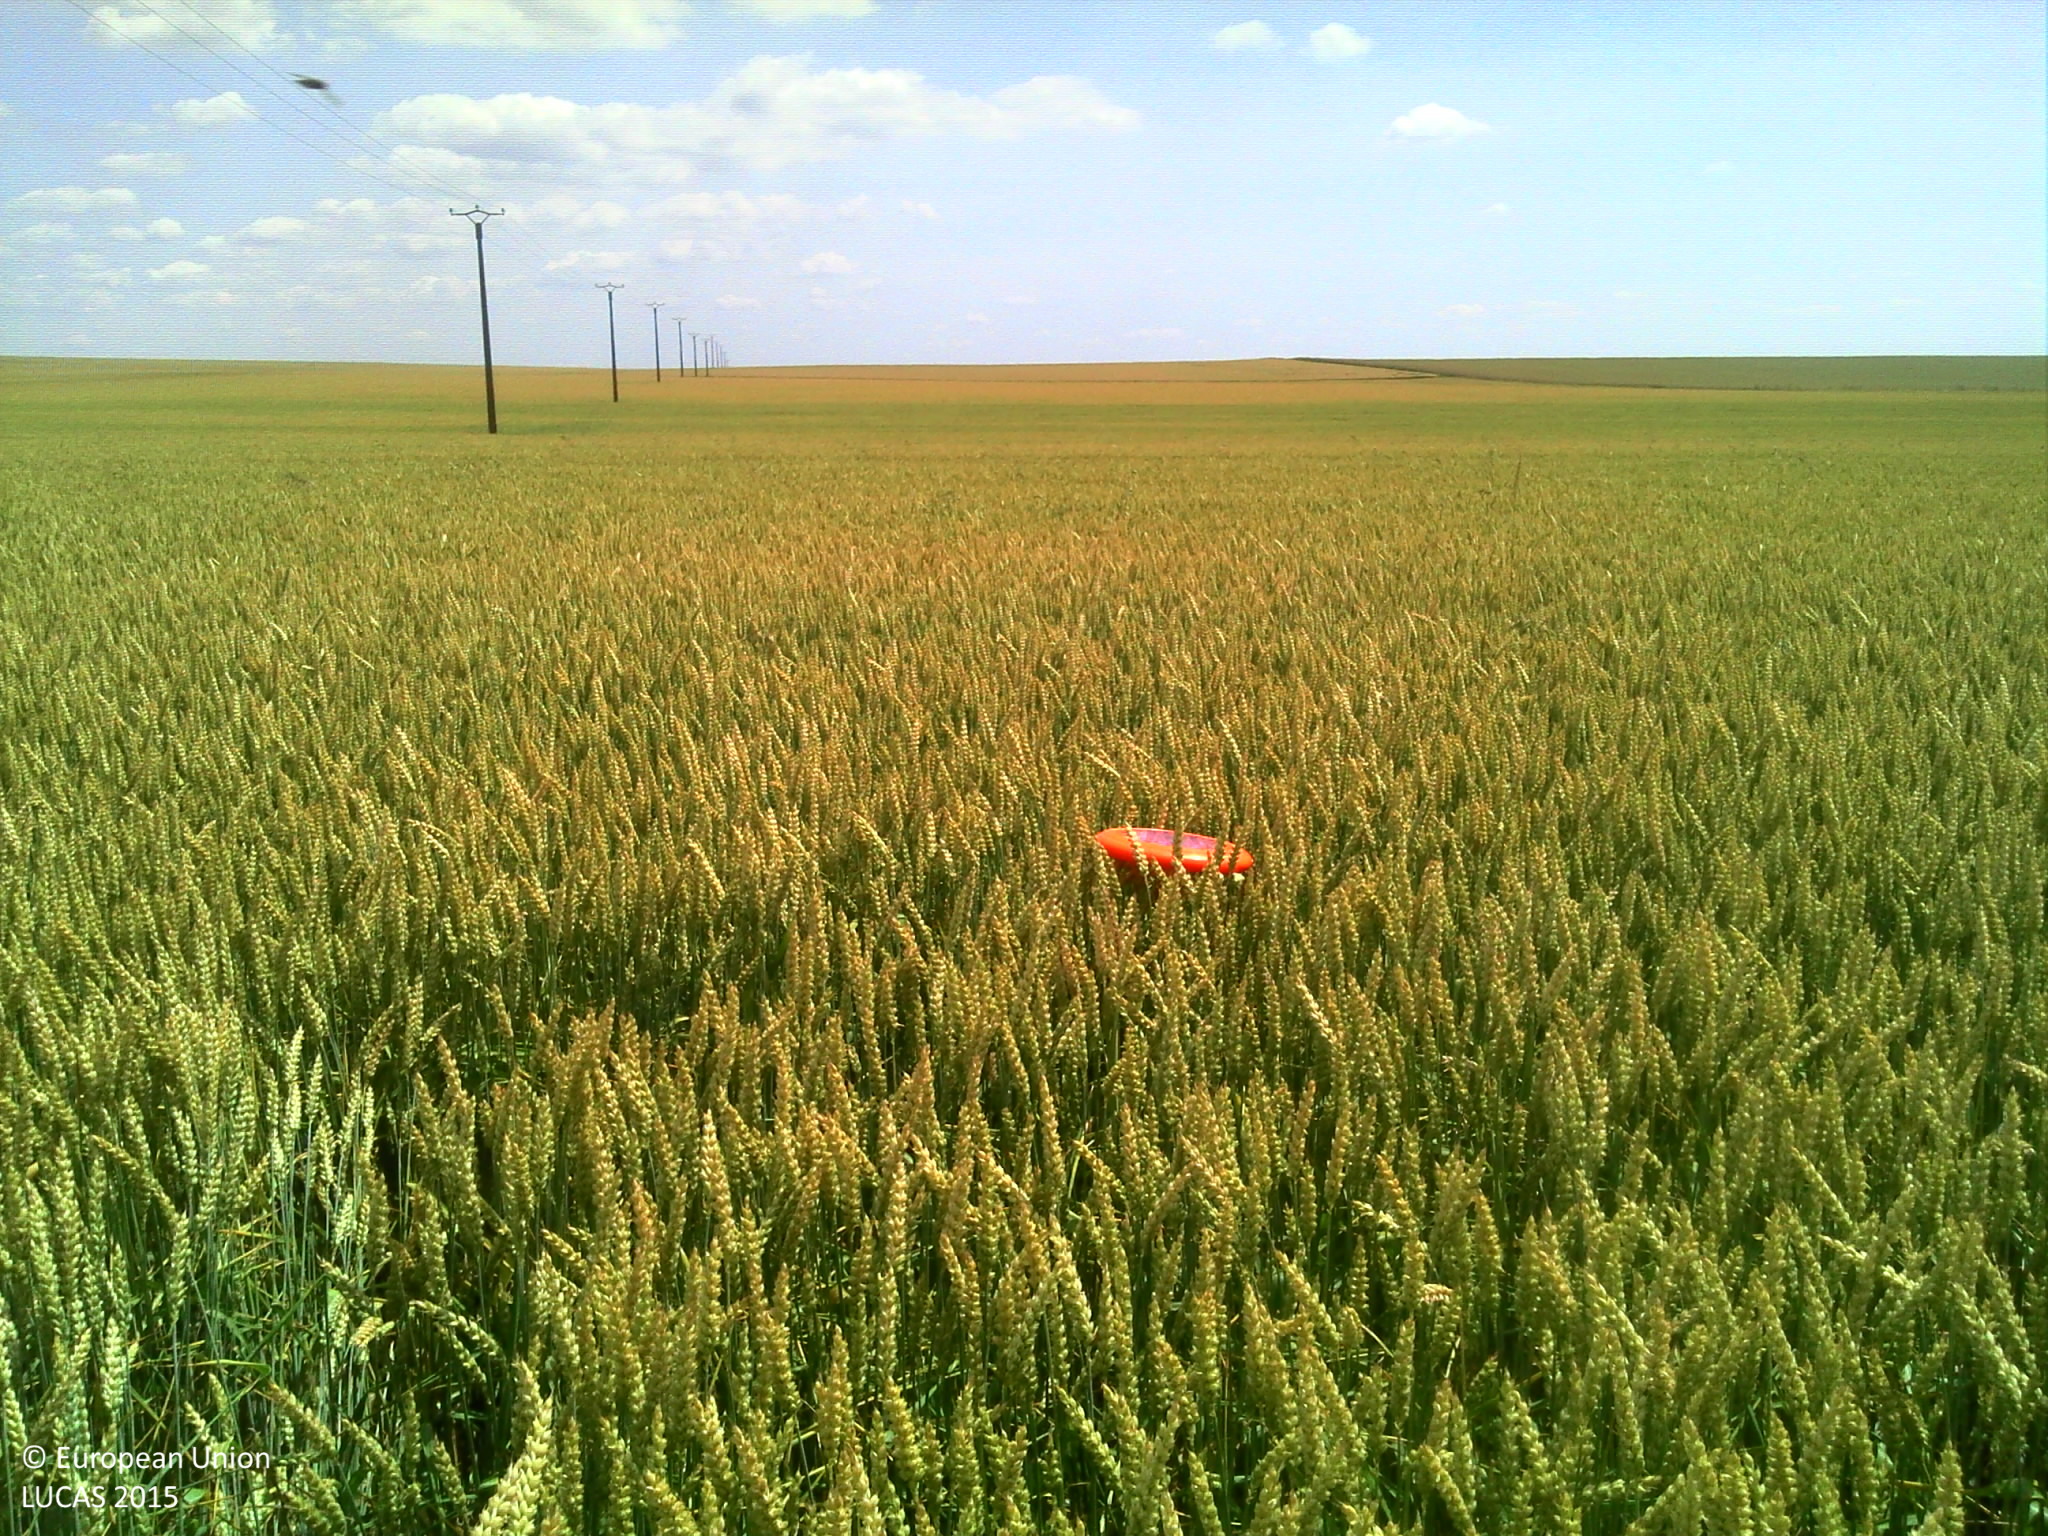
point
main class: Cropland
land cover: Common wheat
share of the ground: > 75 %
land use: Agriculture (excluding fallow land and kitchen gardens)
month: June
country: FR
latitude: 47.9969
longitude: 3.5220
